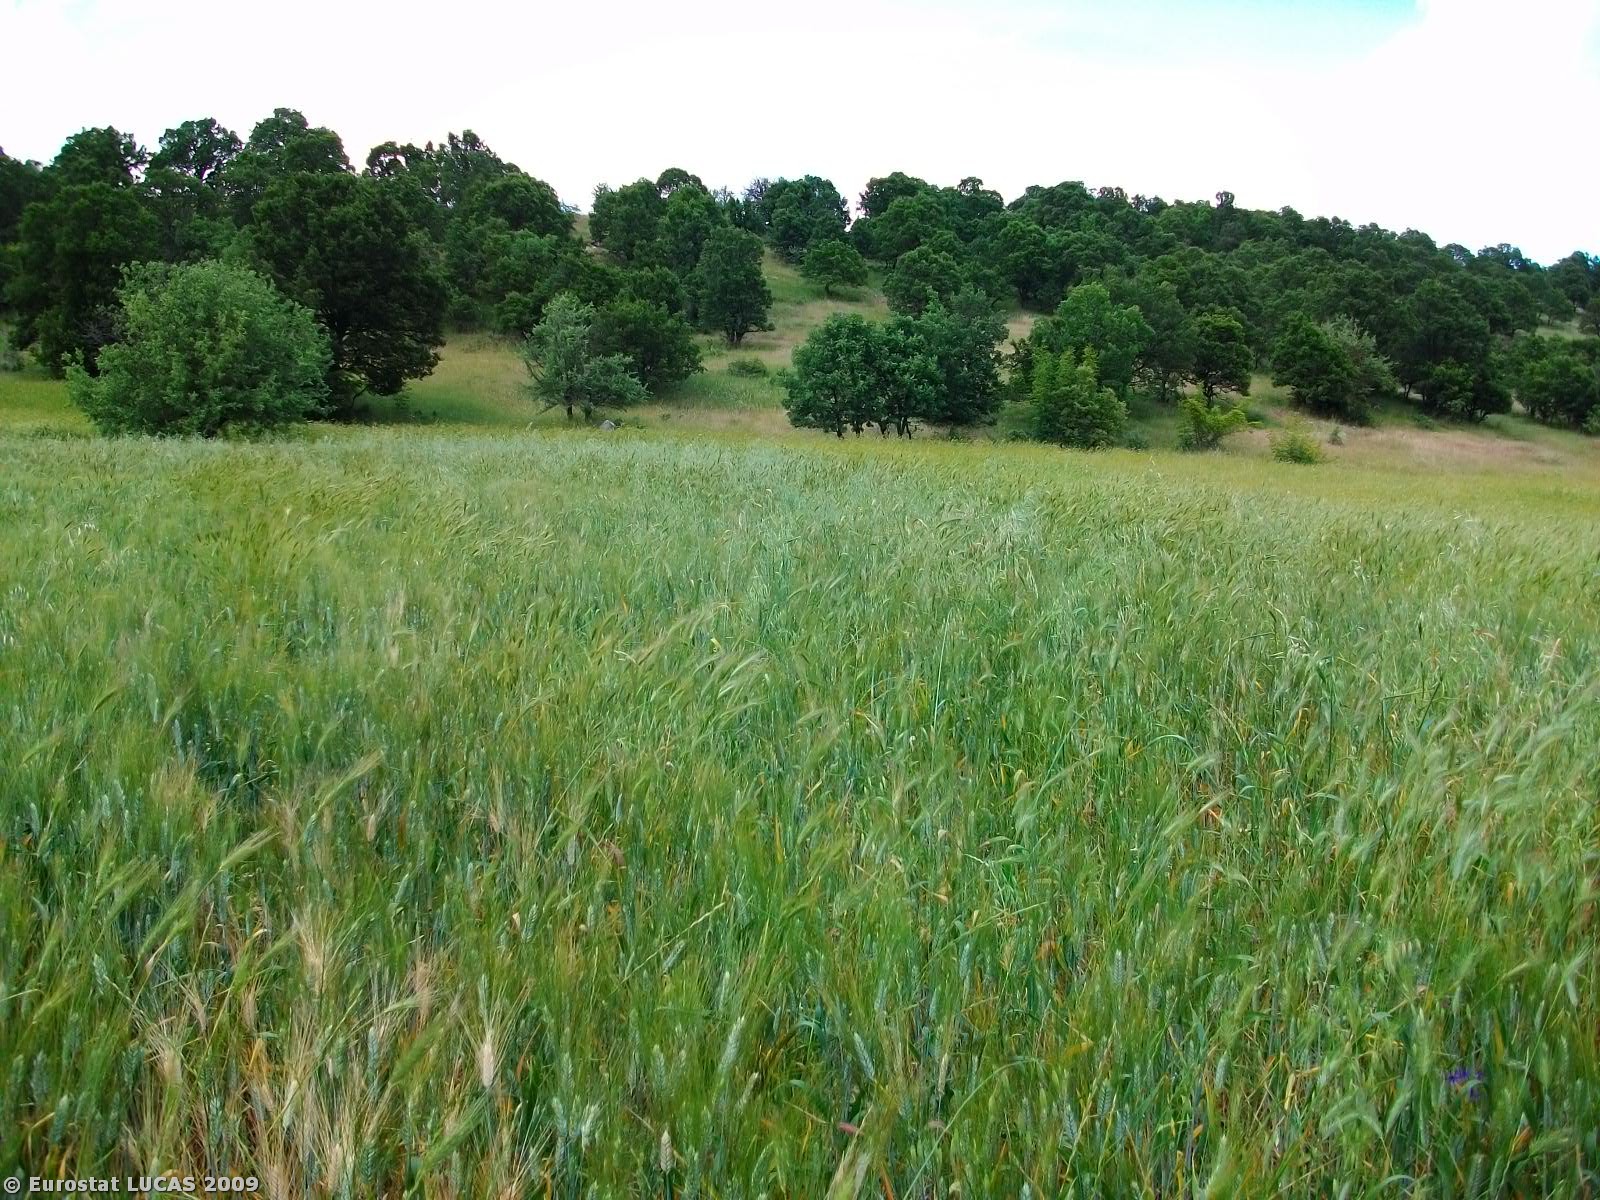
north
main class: Cropland
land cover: Common wheat
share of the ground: > 75 %
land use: Agriculture (excluding fallow land and kitchen gardens)
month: June
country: GR
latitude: 39.9808
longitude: 21.7330
